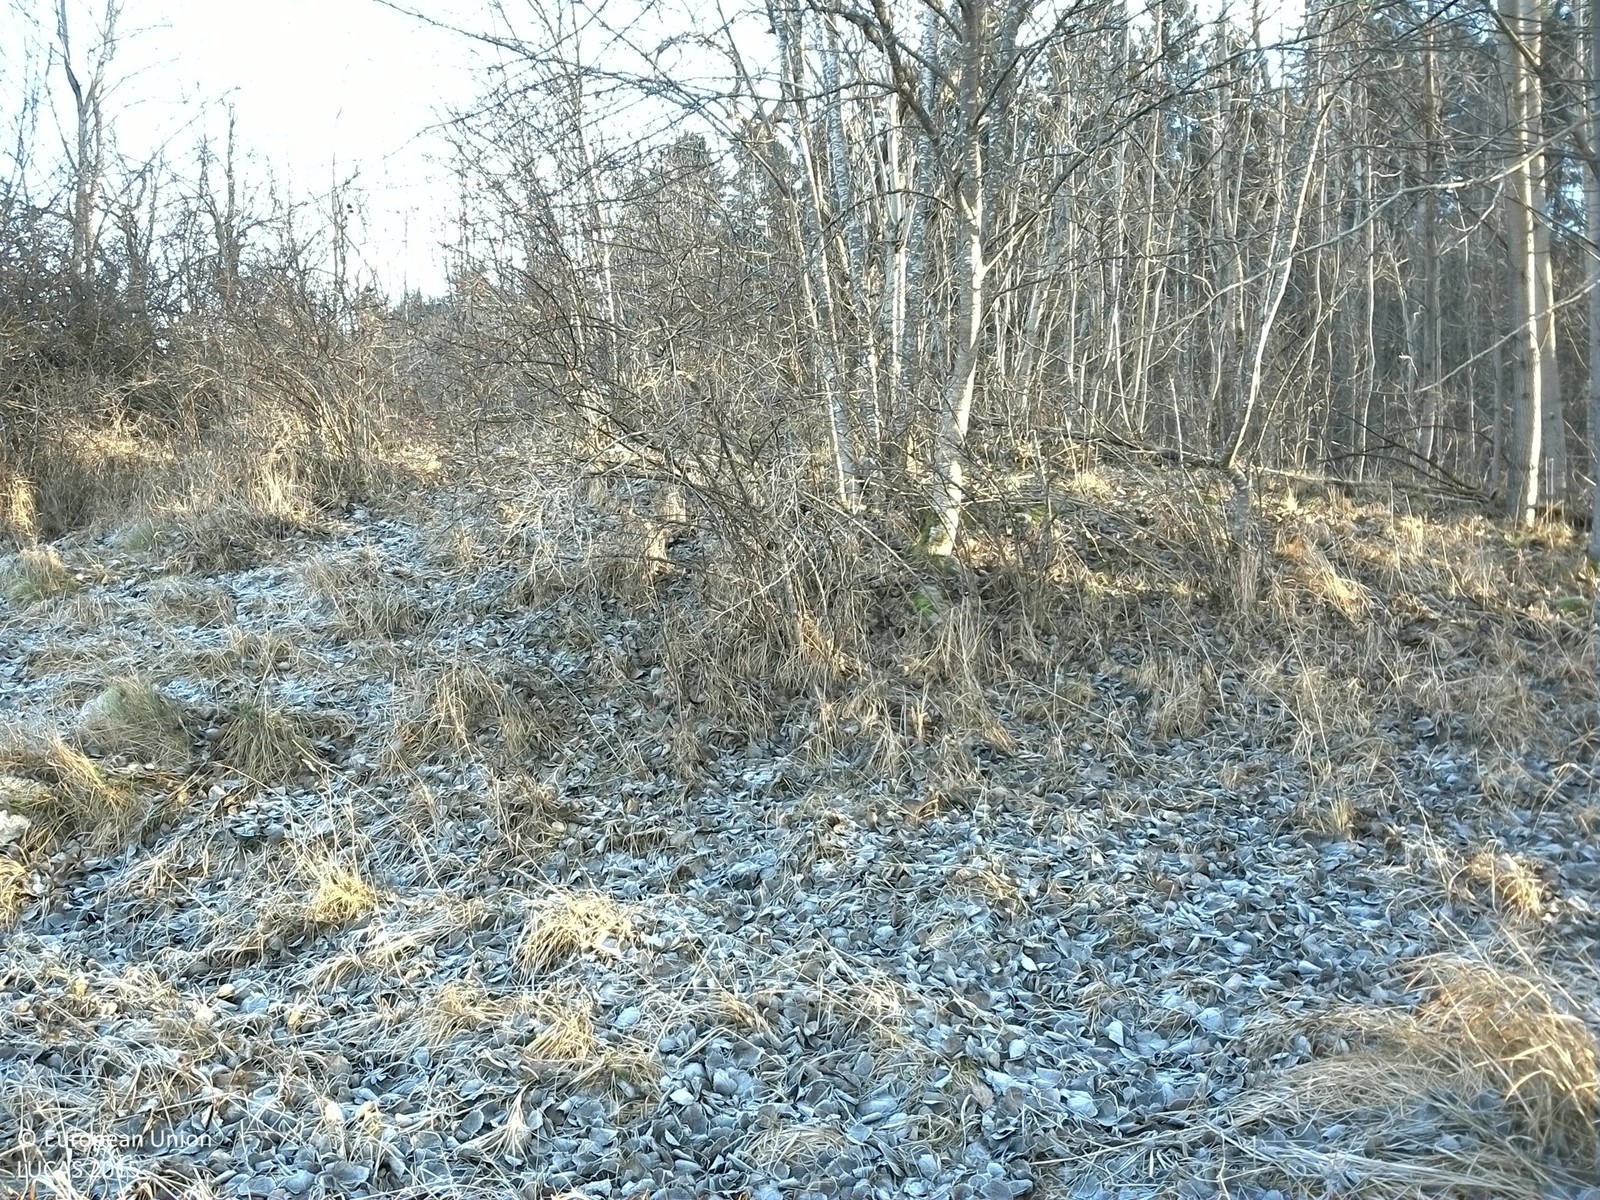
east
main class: Grassland
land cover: Grassland with sparse tree/shrub cover
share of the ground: > 75 %
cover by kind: herbaceous plants 90 %, broadleaved forest trees 5 %, shrubs 5 %
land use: Fallow land
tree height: > 5 m
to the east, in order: Grassland with sparse tree/shrub cover; Broadleaved woodland; Spruce dominated mixed woodland; Other mixed woodland; Grassland with sparse tree/shrub cover; Electric lines; Pine dominated mixed woodland; Other coniferous woodland; Pine dominated mixed woodland; Spruce dominated coniferous woodland
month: December
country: SE
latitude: 59.4168
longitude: 16.4949
